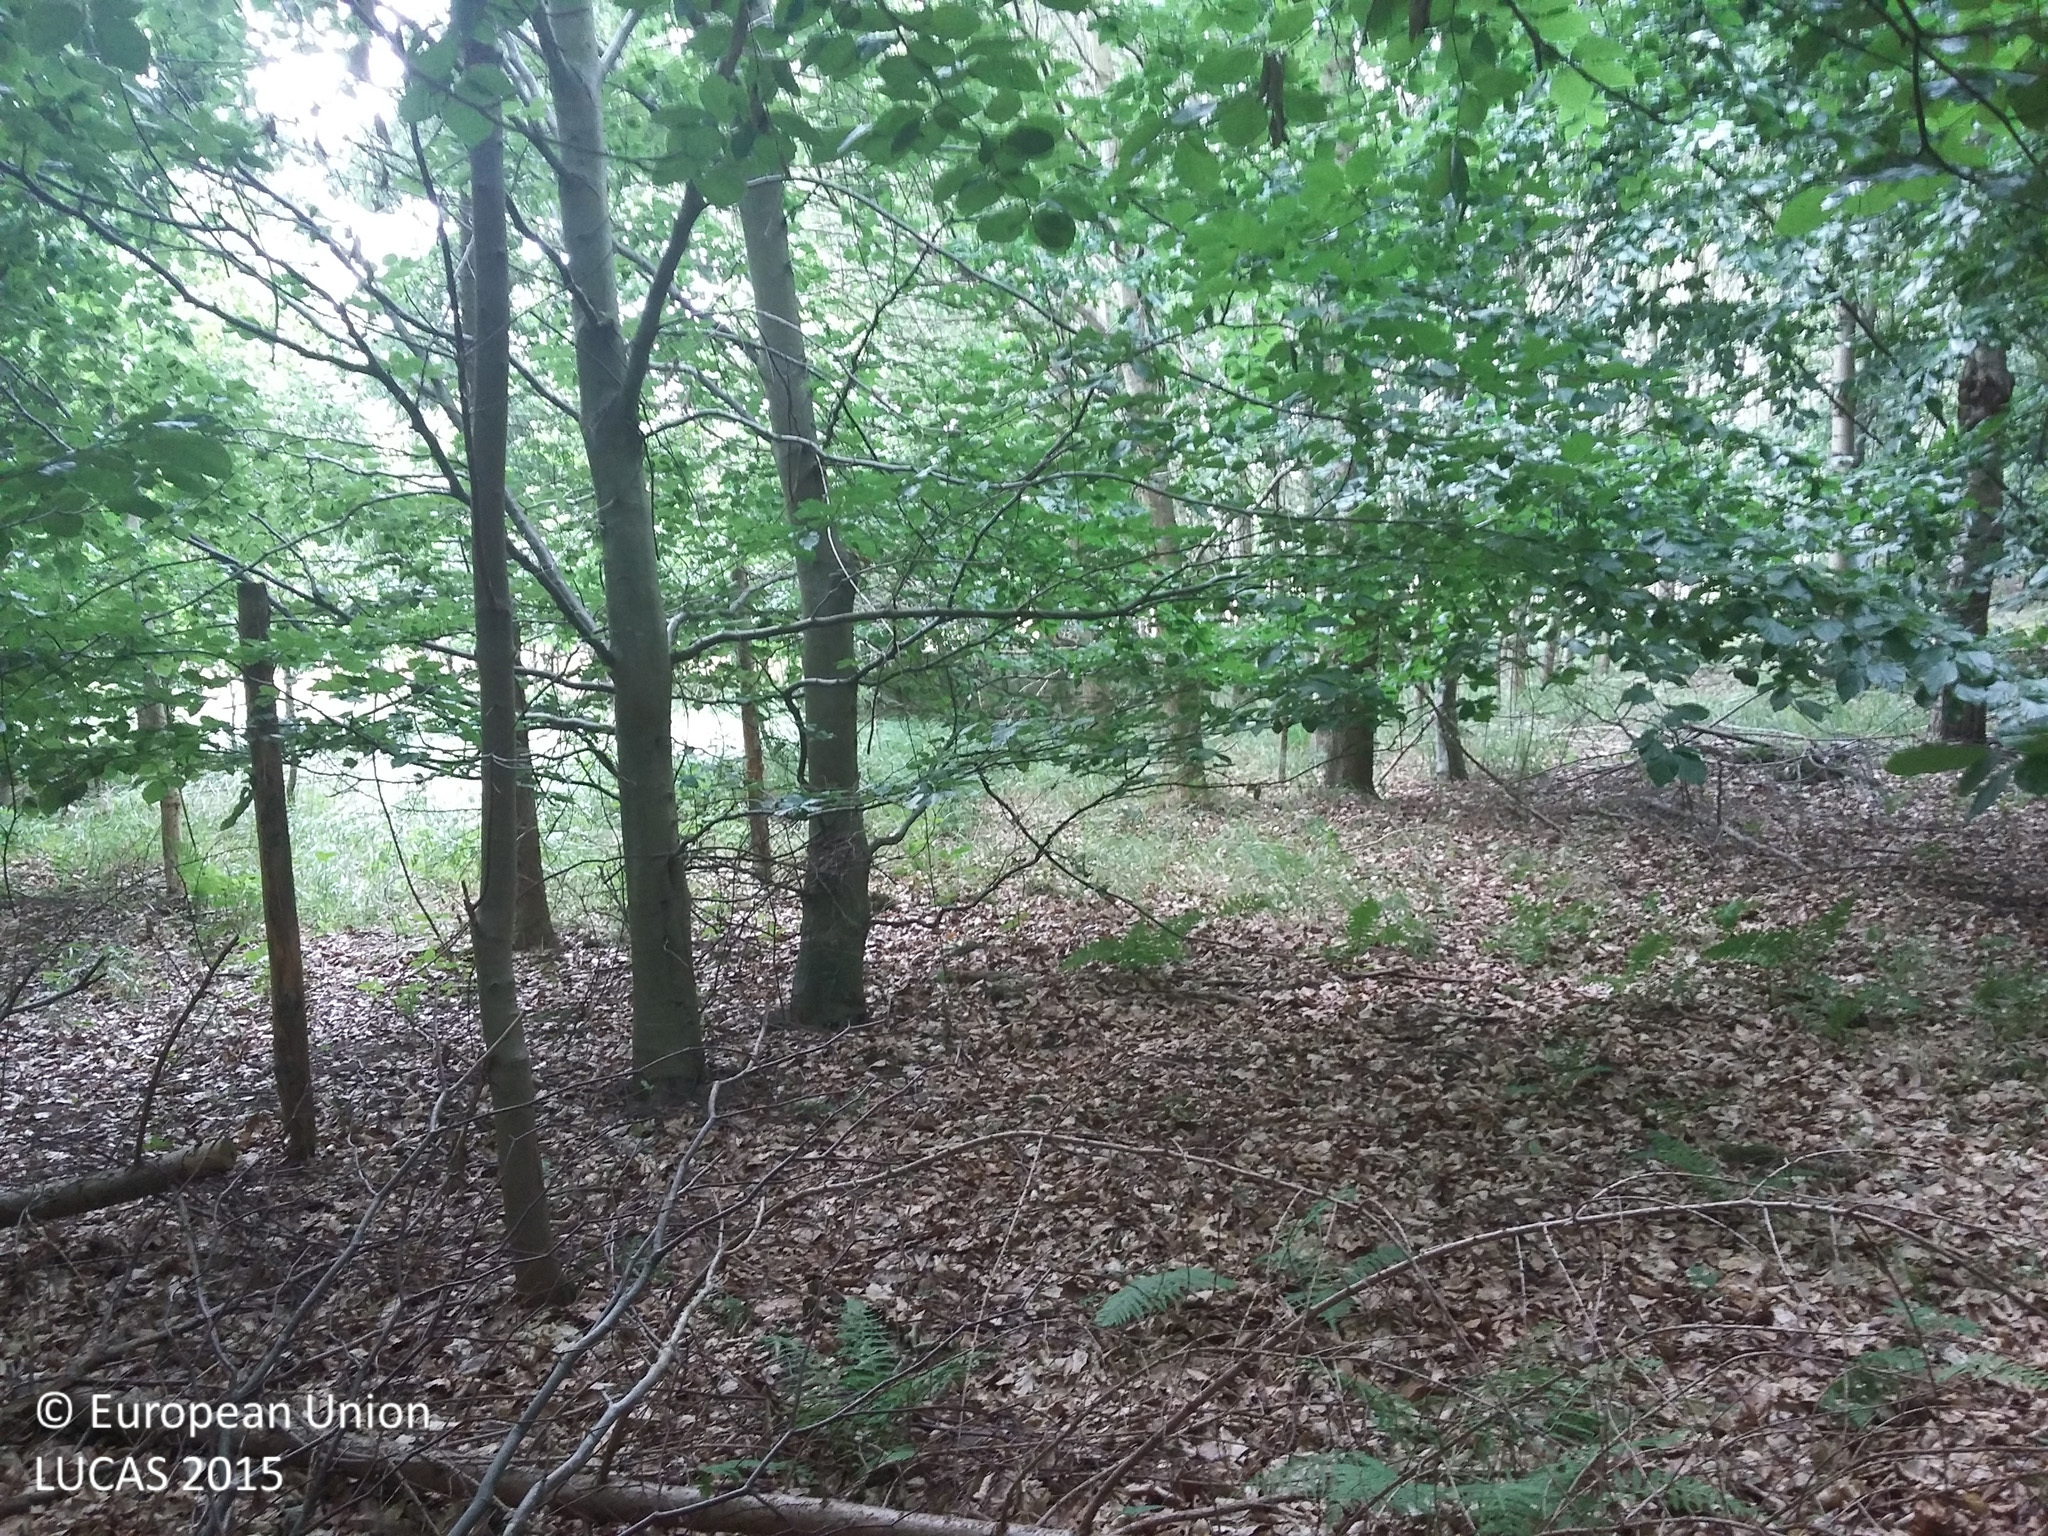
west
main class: Woodland
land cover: Broadleaved woodland
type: beech forest
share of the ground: > 75 %
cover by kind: broadleaved forest trees 95 %, unconsolidated bare surface 5 %
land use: Forestry
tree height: > 5 m
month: July
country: DK
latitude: 55.7398
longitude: 12.0528
